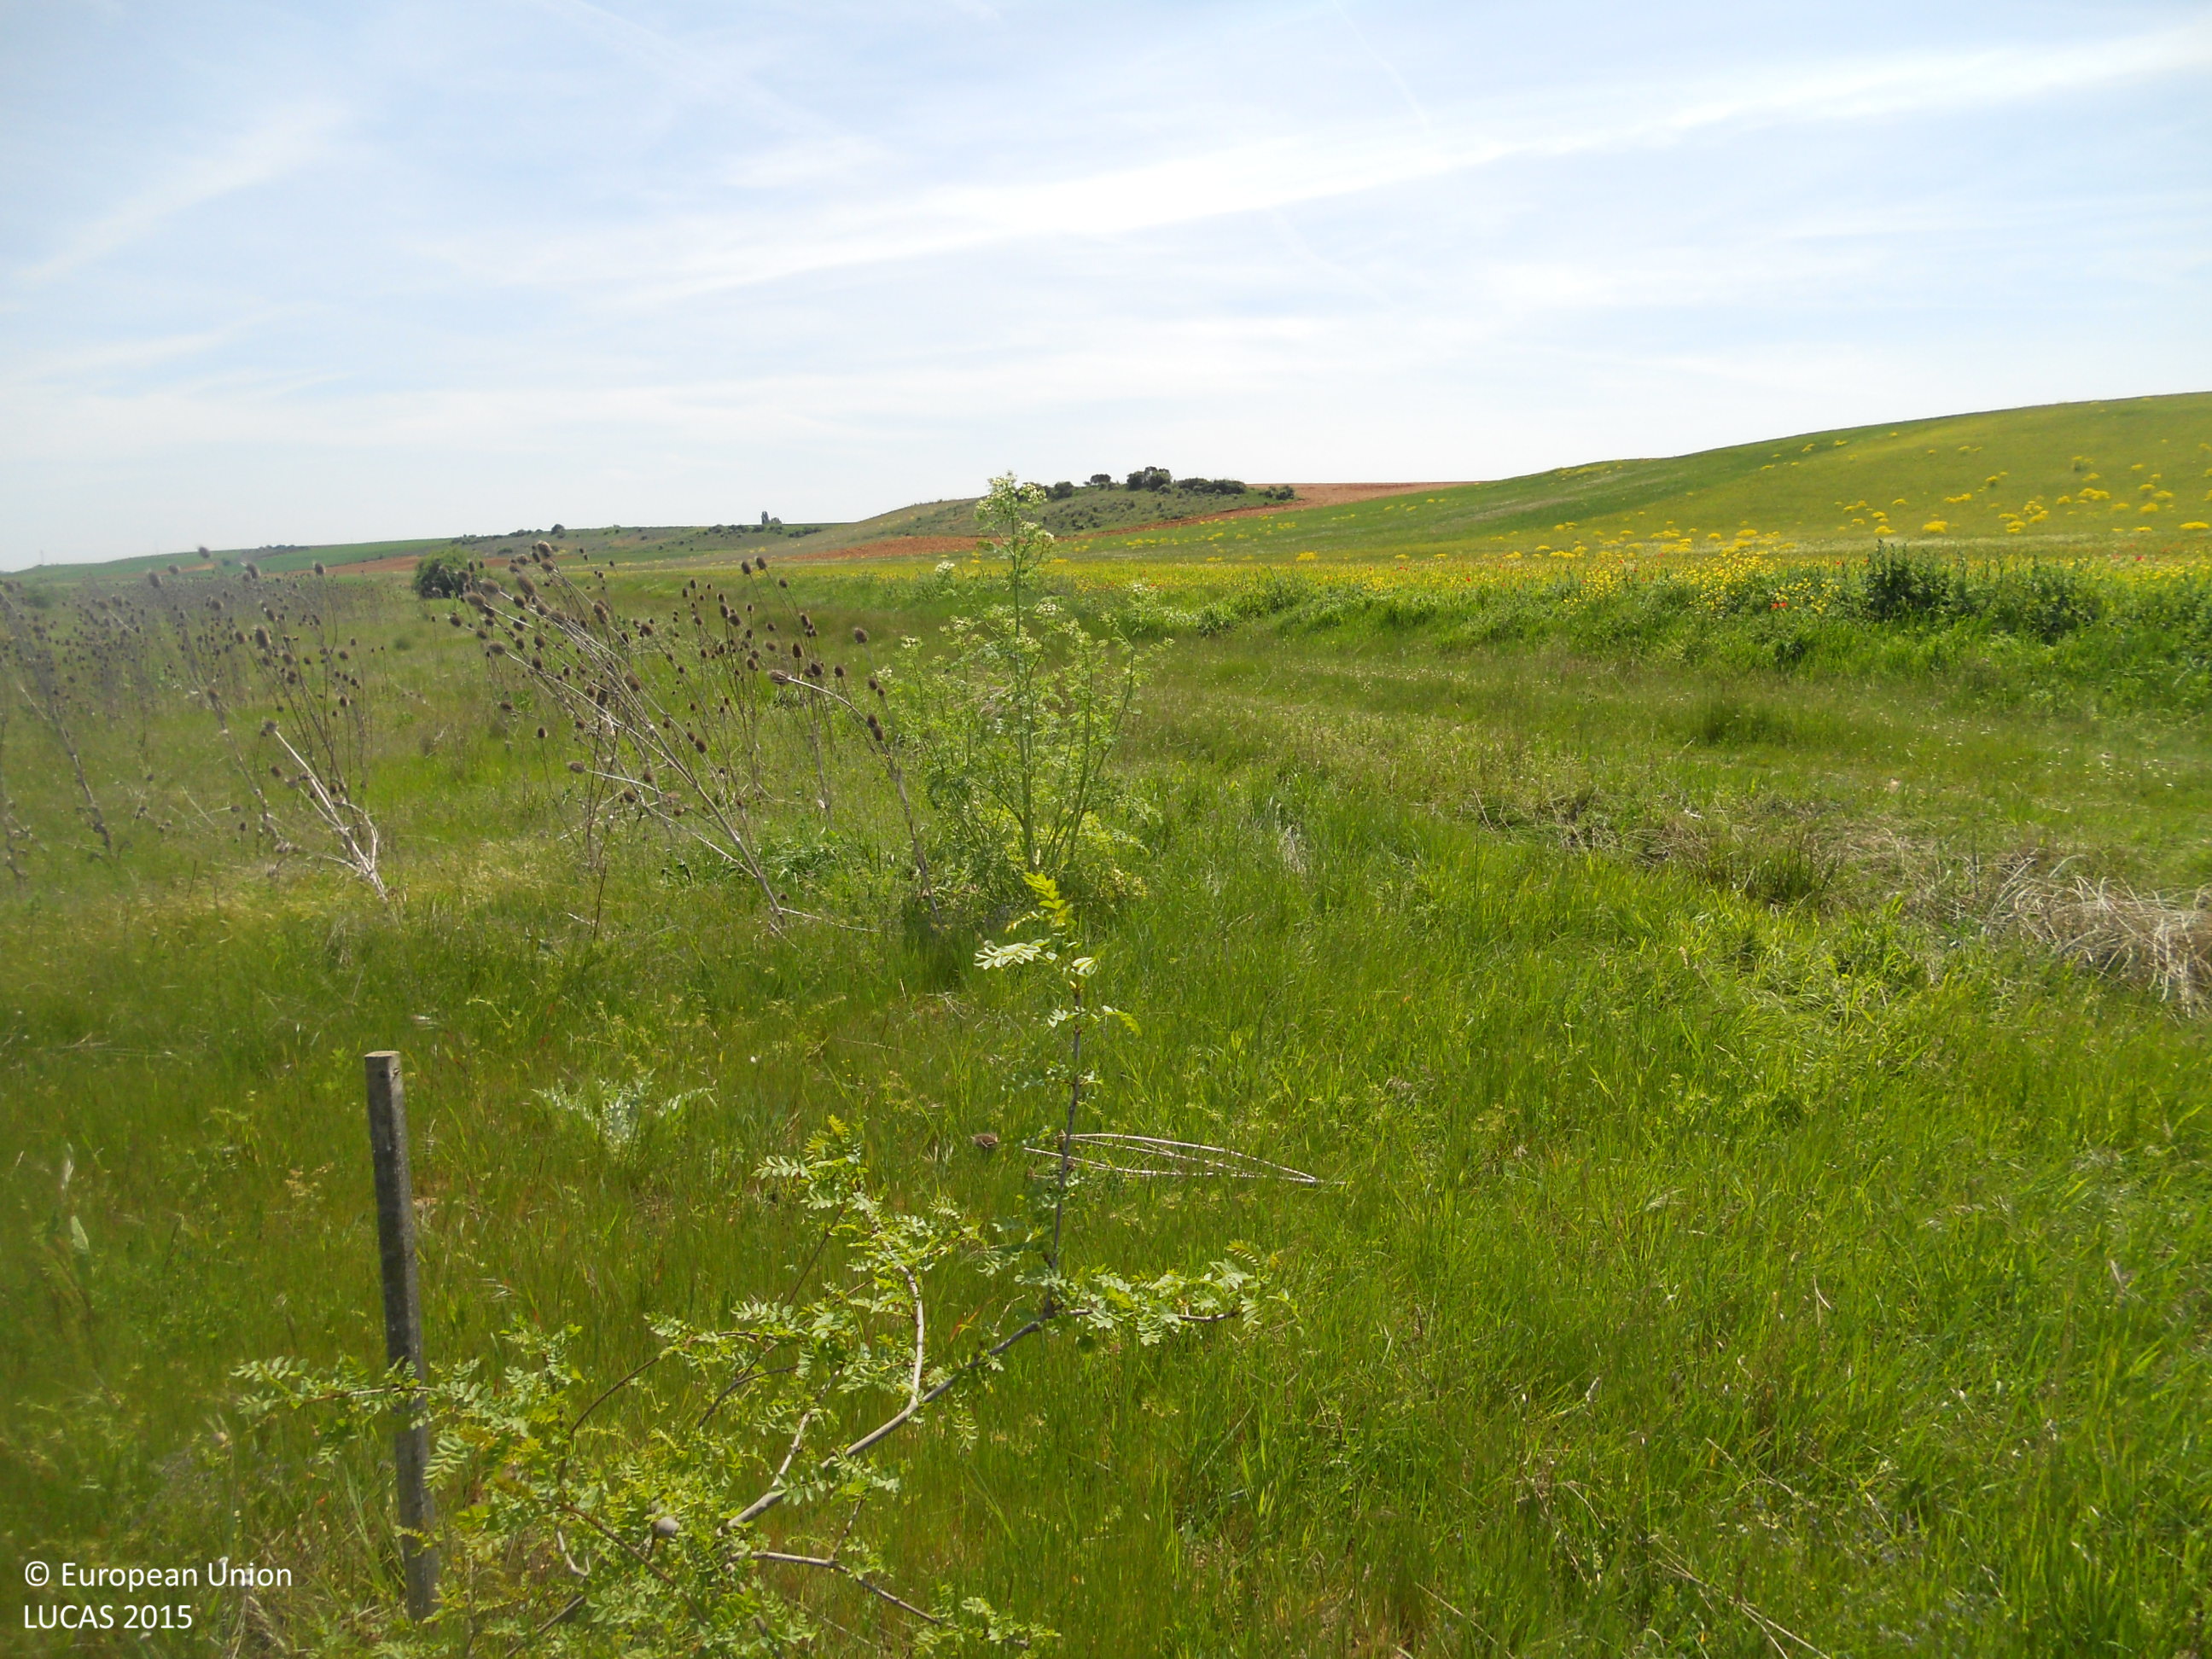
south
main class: Grassland
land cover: Grassland without tree/shrub cover
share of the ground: > 75 %
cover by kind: herbaceous plants 100 %
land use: Forestry
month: May
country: ES
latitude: 42.3462
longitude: -5.2984
